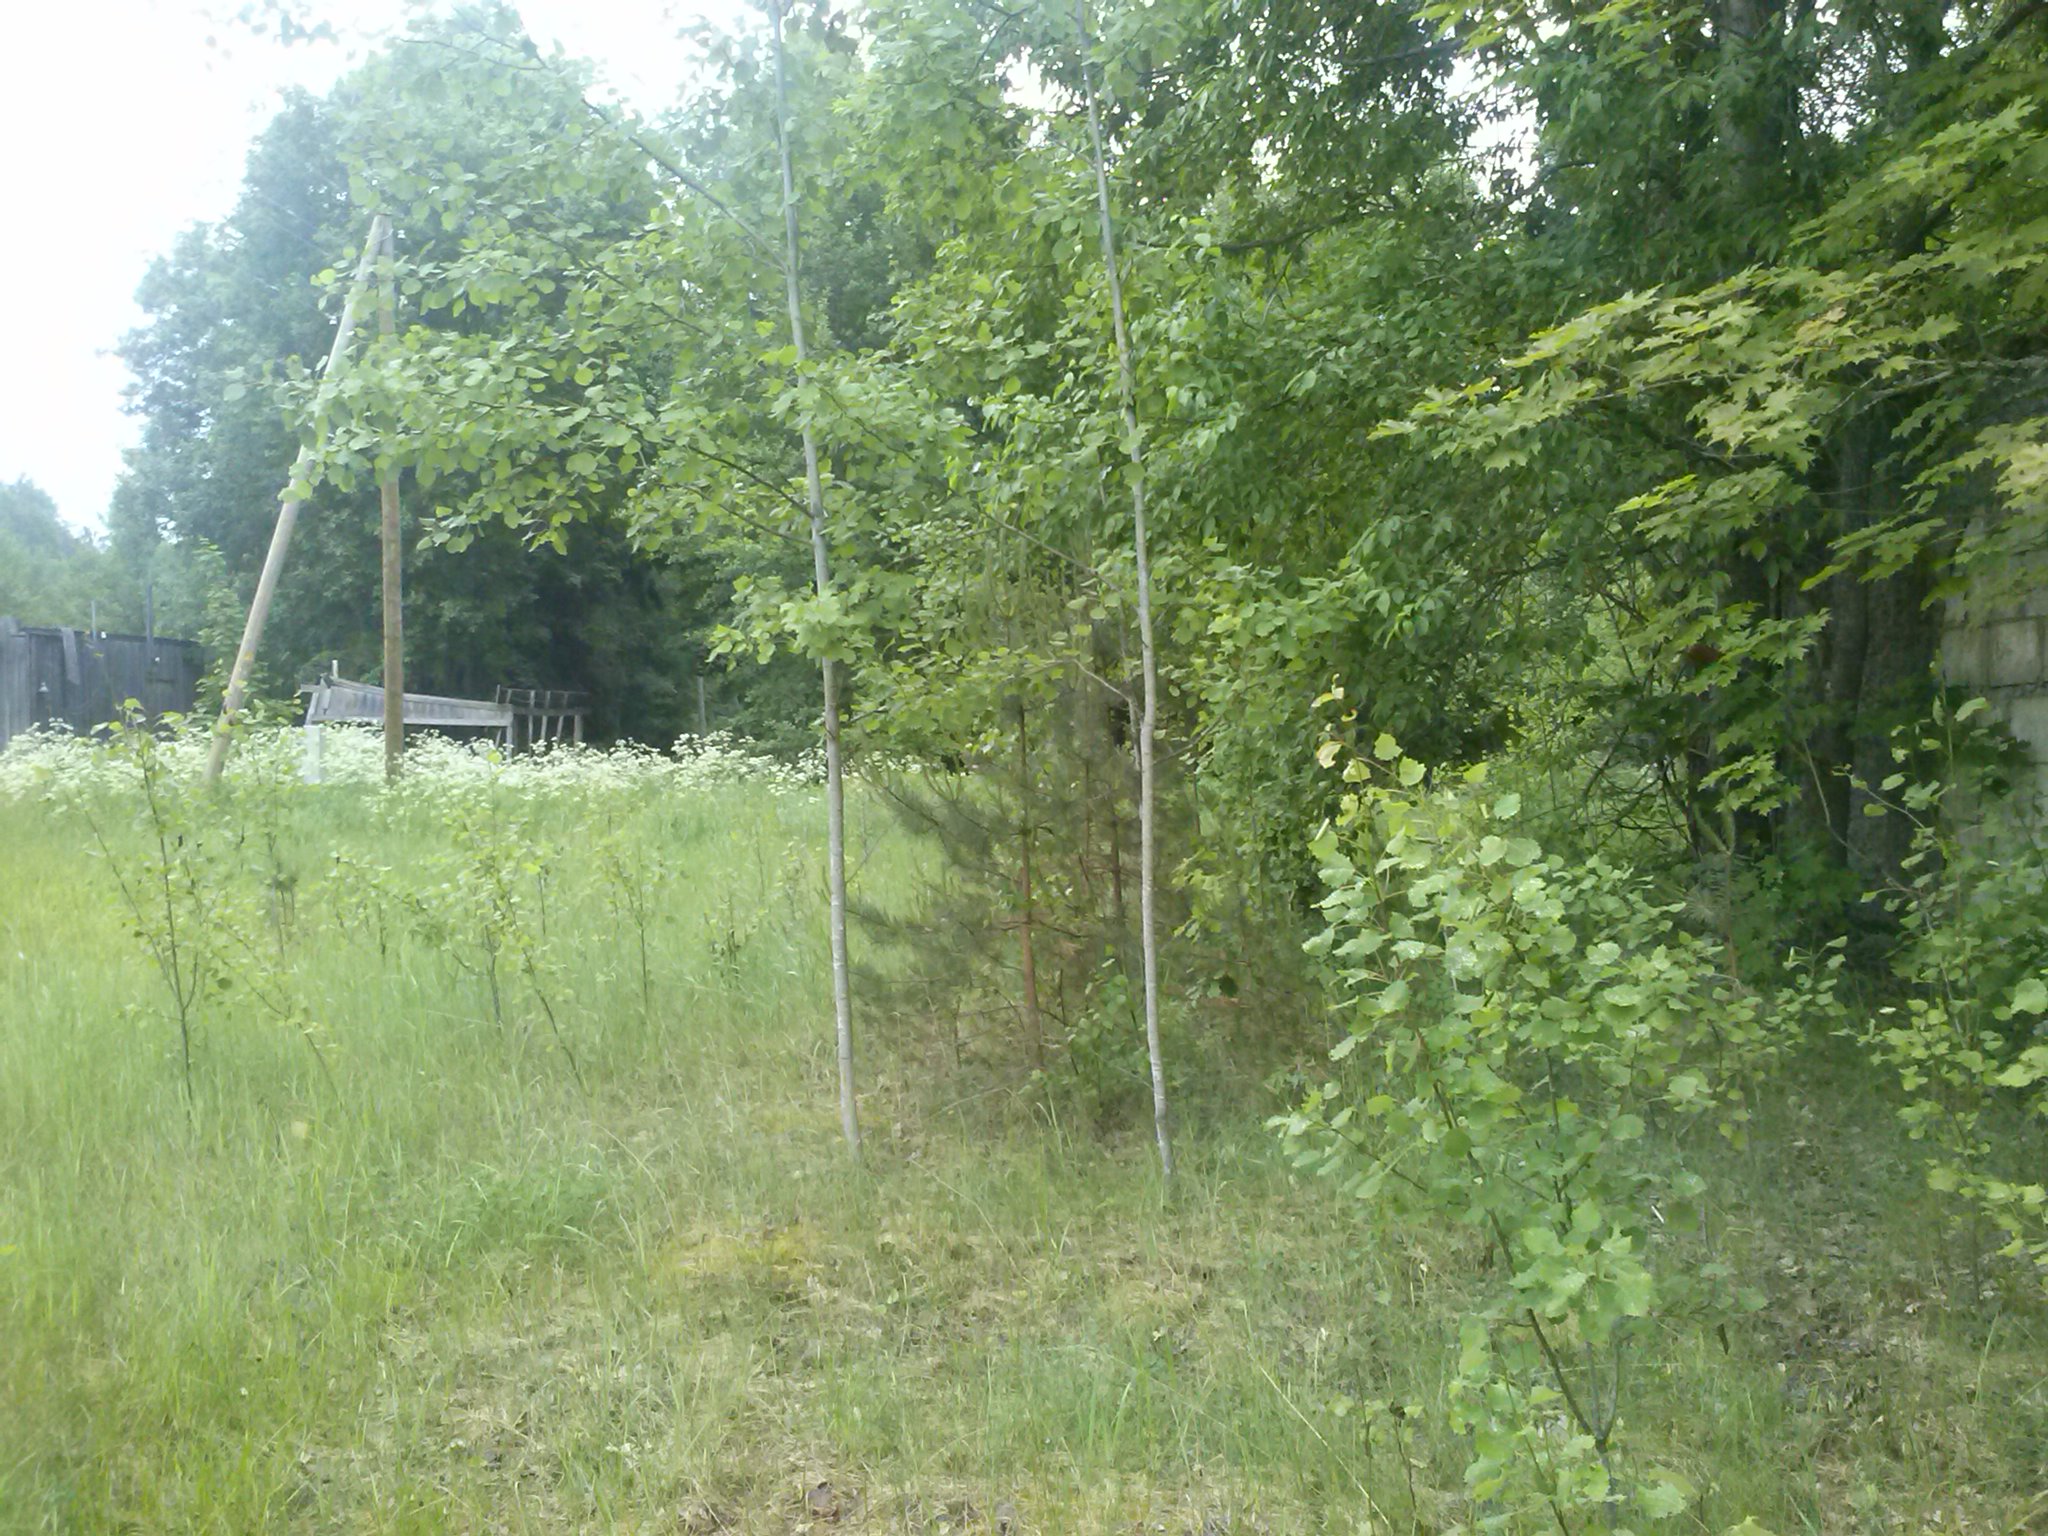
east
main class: Woodland
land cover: Broadleaved woodland
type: non-riverine alder, birch or aspen forest
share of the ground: 50 - 75 %
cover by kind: broadleaved forest trees 50 %, herbaceous plants 40 %, coniferous forest trees 5 %, shrubs 5 %
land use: Abandoned areas
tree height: > 5 m
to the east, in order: Broadleaved woodland; Grassland with sparse tree/shrub cover; Electric lines; Grassland with sparse tree/shrub cover; Artificial constructions in urban areas; Broadleaved woodland; Paved roads, cycling and walking lanes; Broadleaved woodland; Rivers and streams; Grassland with sparse tree/shrub cover; Broadleaved woodland; Shrubland without tree cover; Spontaneously vegetated surfaces
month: June
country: LV
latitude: 56.9127
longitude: 27.1993
